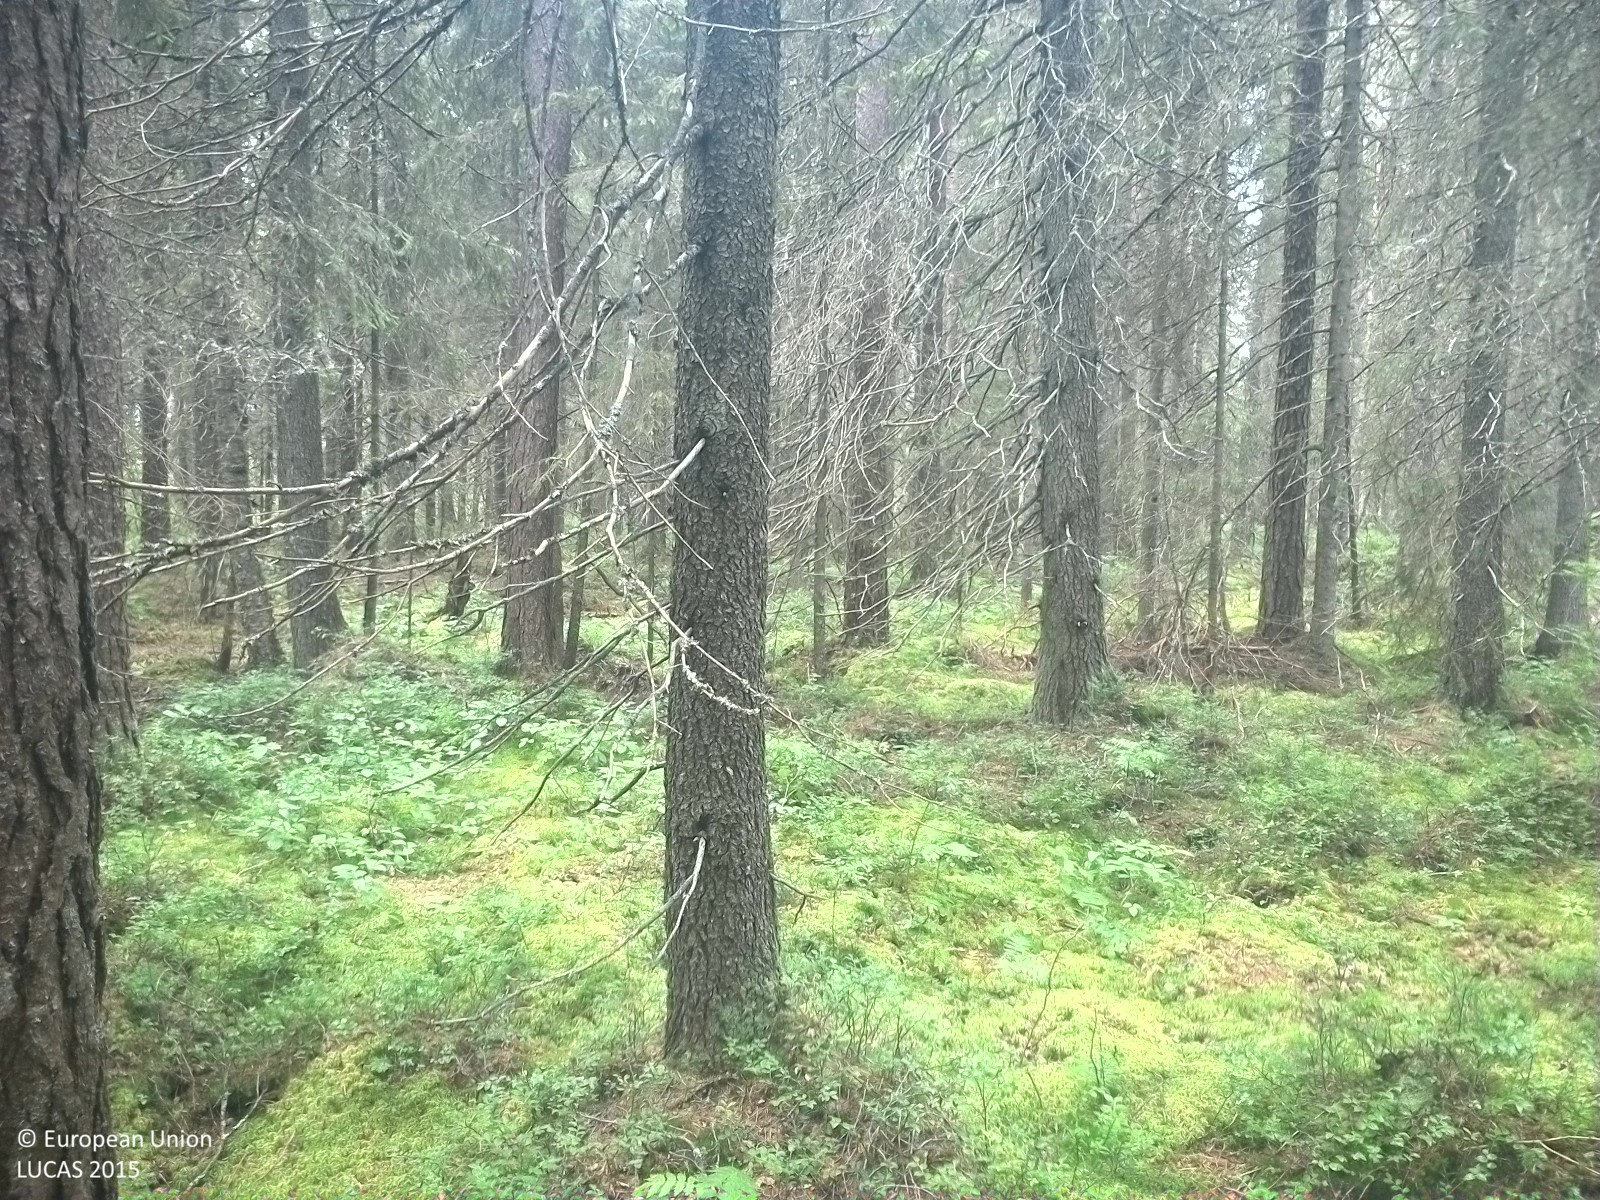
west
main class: Woodland
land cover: Spruce dominated coniferous woodland
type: boreal forest
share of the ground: 50 - 75 %
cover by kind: coniferous forest trees 60 %, lichens and mosses 30 %, herbaceous plants 10 %
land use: Forestry
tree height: > 5 m
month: July
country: SE
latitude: 62.5581
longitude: 17.7410
